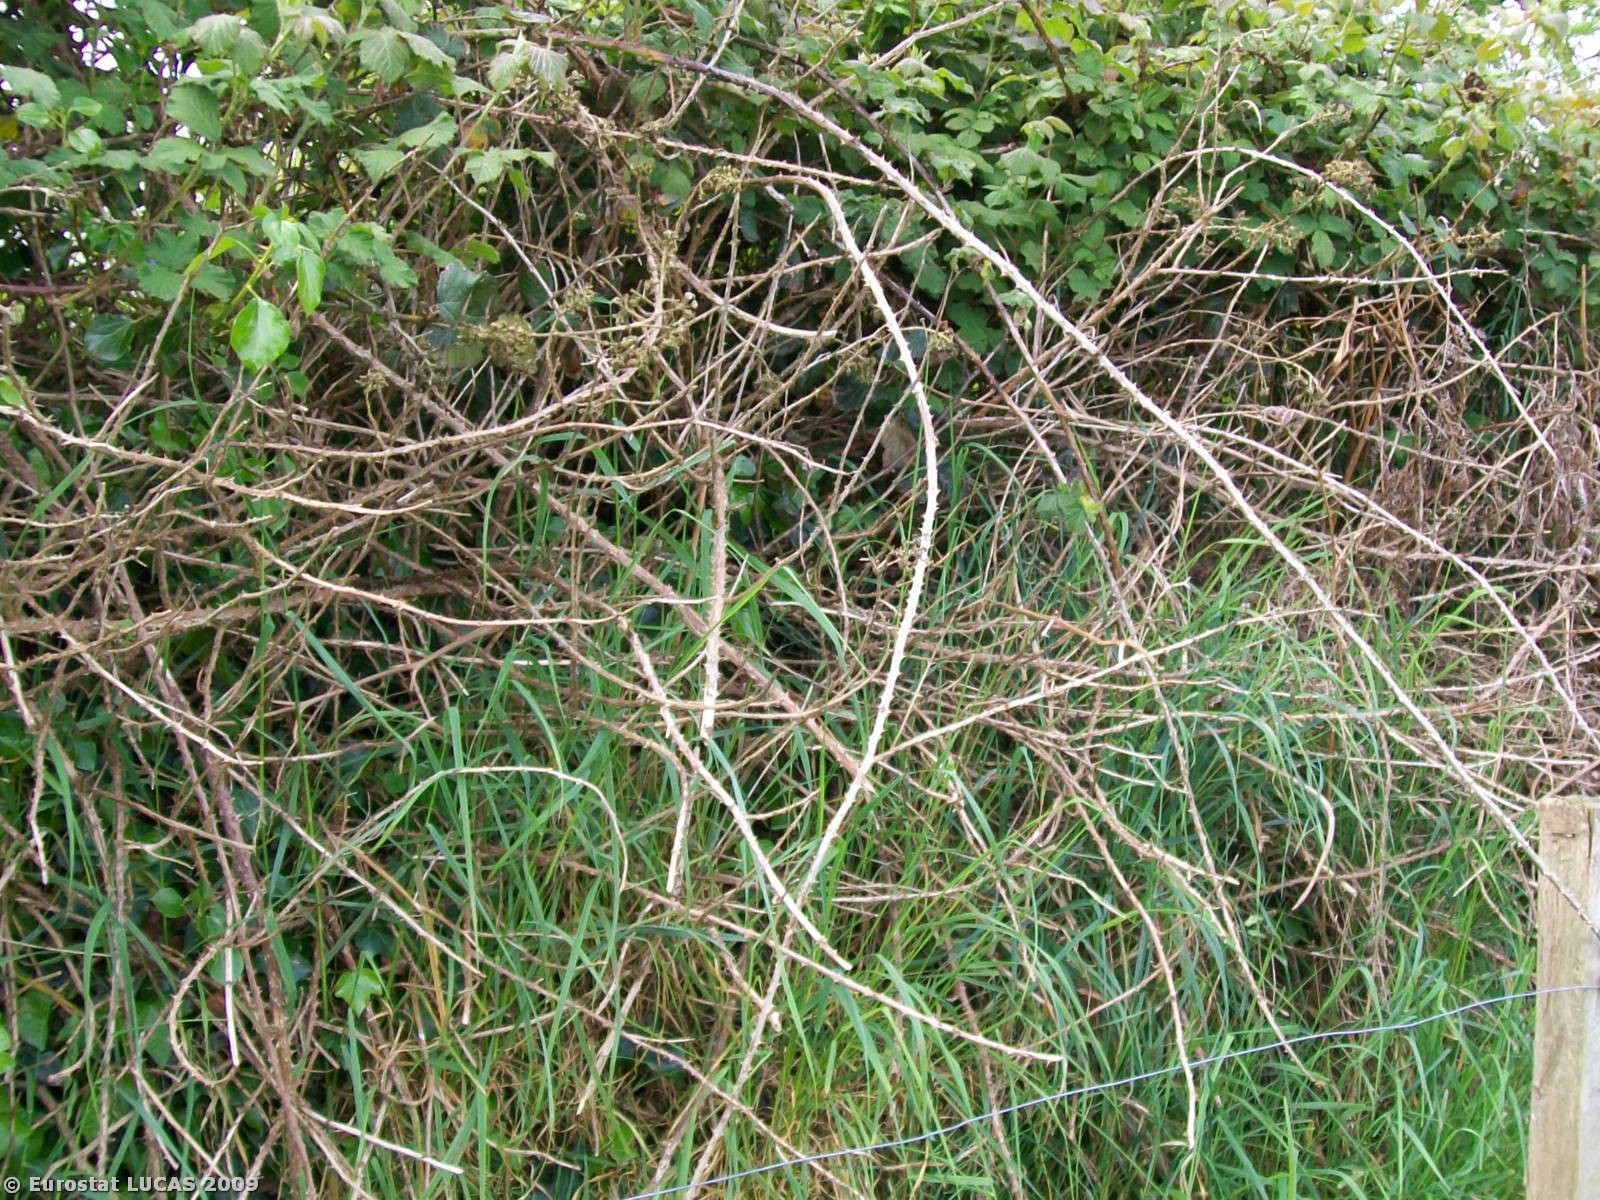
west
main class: Grassland
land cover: Grassland without tree/shrub cover
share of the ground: > 75 %
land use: Agriculture (excluding fallow land and kitchen gardens)
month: May
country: IE
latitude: 51.7837
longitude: -8.7735
